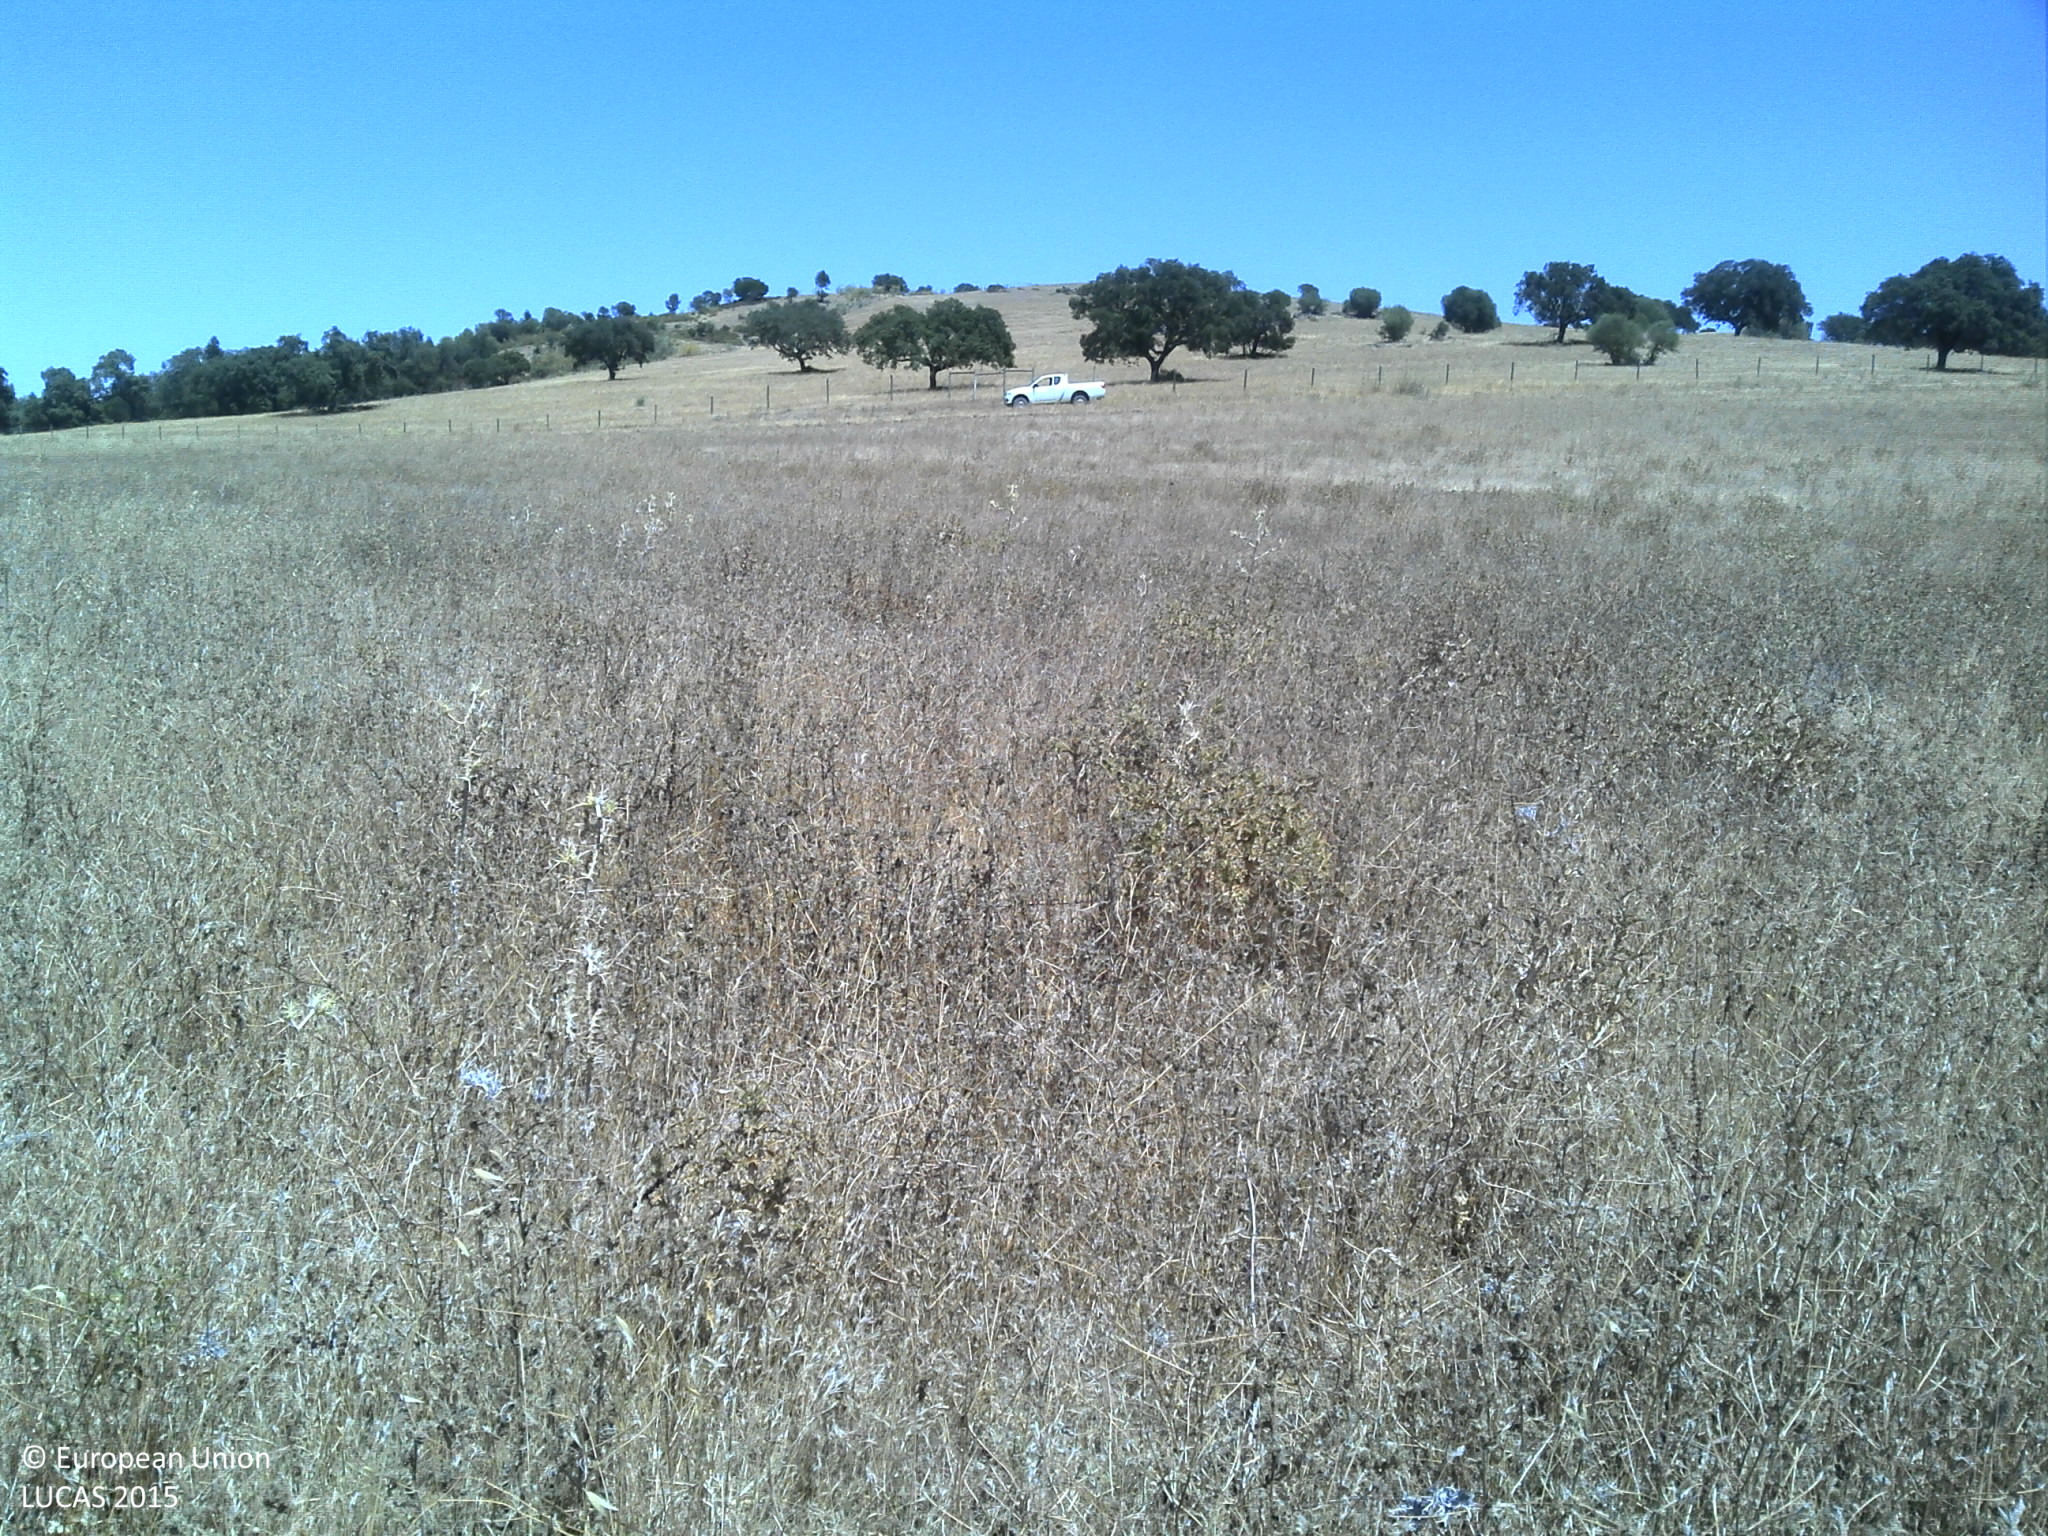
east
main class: Grassland
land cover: Grassland without tree/shrub cover
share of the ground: > 75 %
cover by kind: herbaceous plants 90 %, unconsolidated bare surface 10 %
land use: Agriculture (excluding fallow land and kitchen gardens)
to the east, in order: Grassland without tree/shrub cover; Other bare soil; Grassland without tree/shrub cover; Tracks; Grass margins; Fences; Grass margins; Other bare soil; Grassland with sparse tree/shrub cover
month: July
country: PT
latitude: 38.0374
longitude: -8.0693
